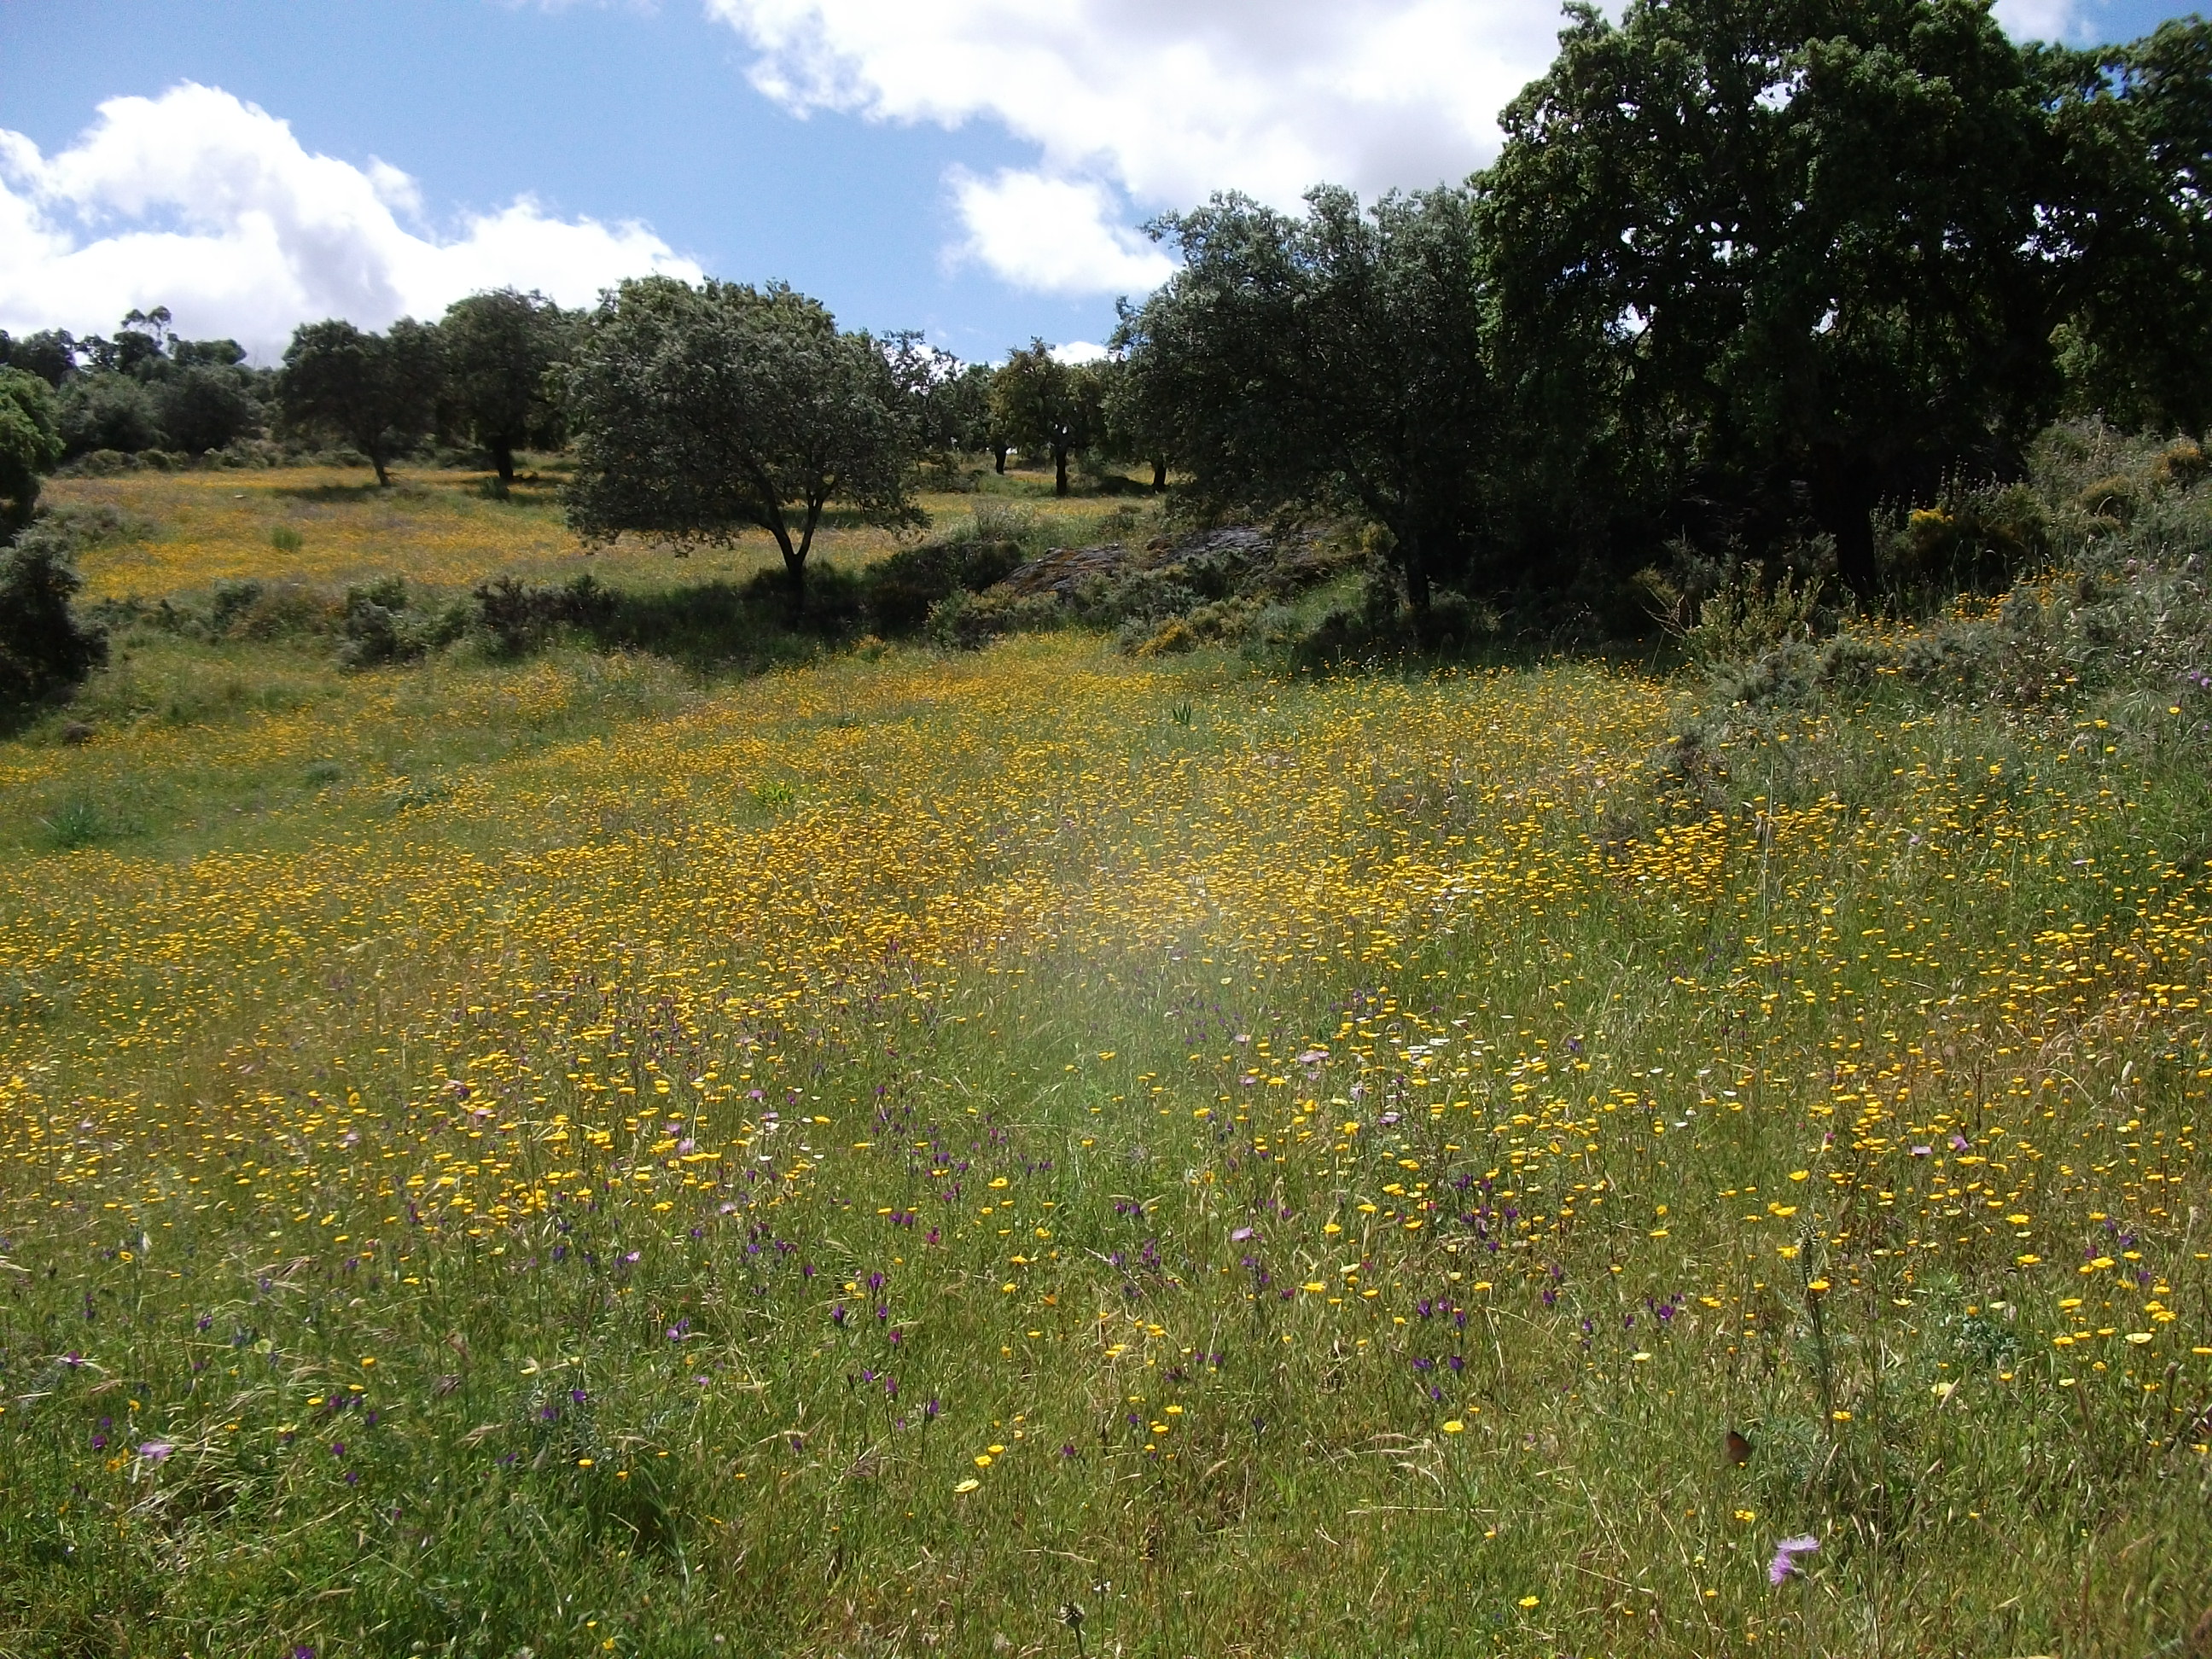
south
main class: Woodland
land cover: Broadleaved woodland
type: broadleaved evergreen forest
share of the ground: 10 - 25 %
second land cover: Grassland without tree/shrub cover
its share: > 75 %
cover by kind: herbaceous plants 85 %, broadleaved forest trees 10 %, shrubs 5 %
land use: Forestry
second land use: Agriculture (excluding fallow land and kitchen gardens)
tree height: > 5 m
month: May
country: ES
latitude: 37.6813
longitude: -6.6989
